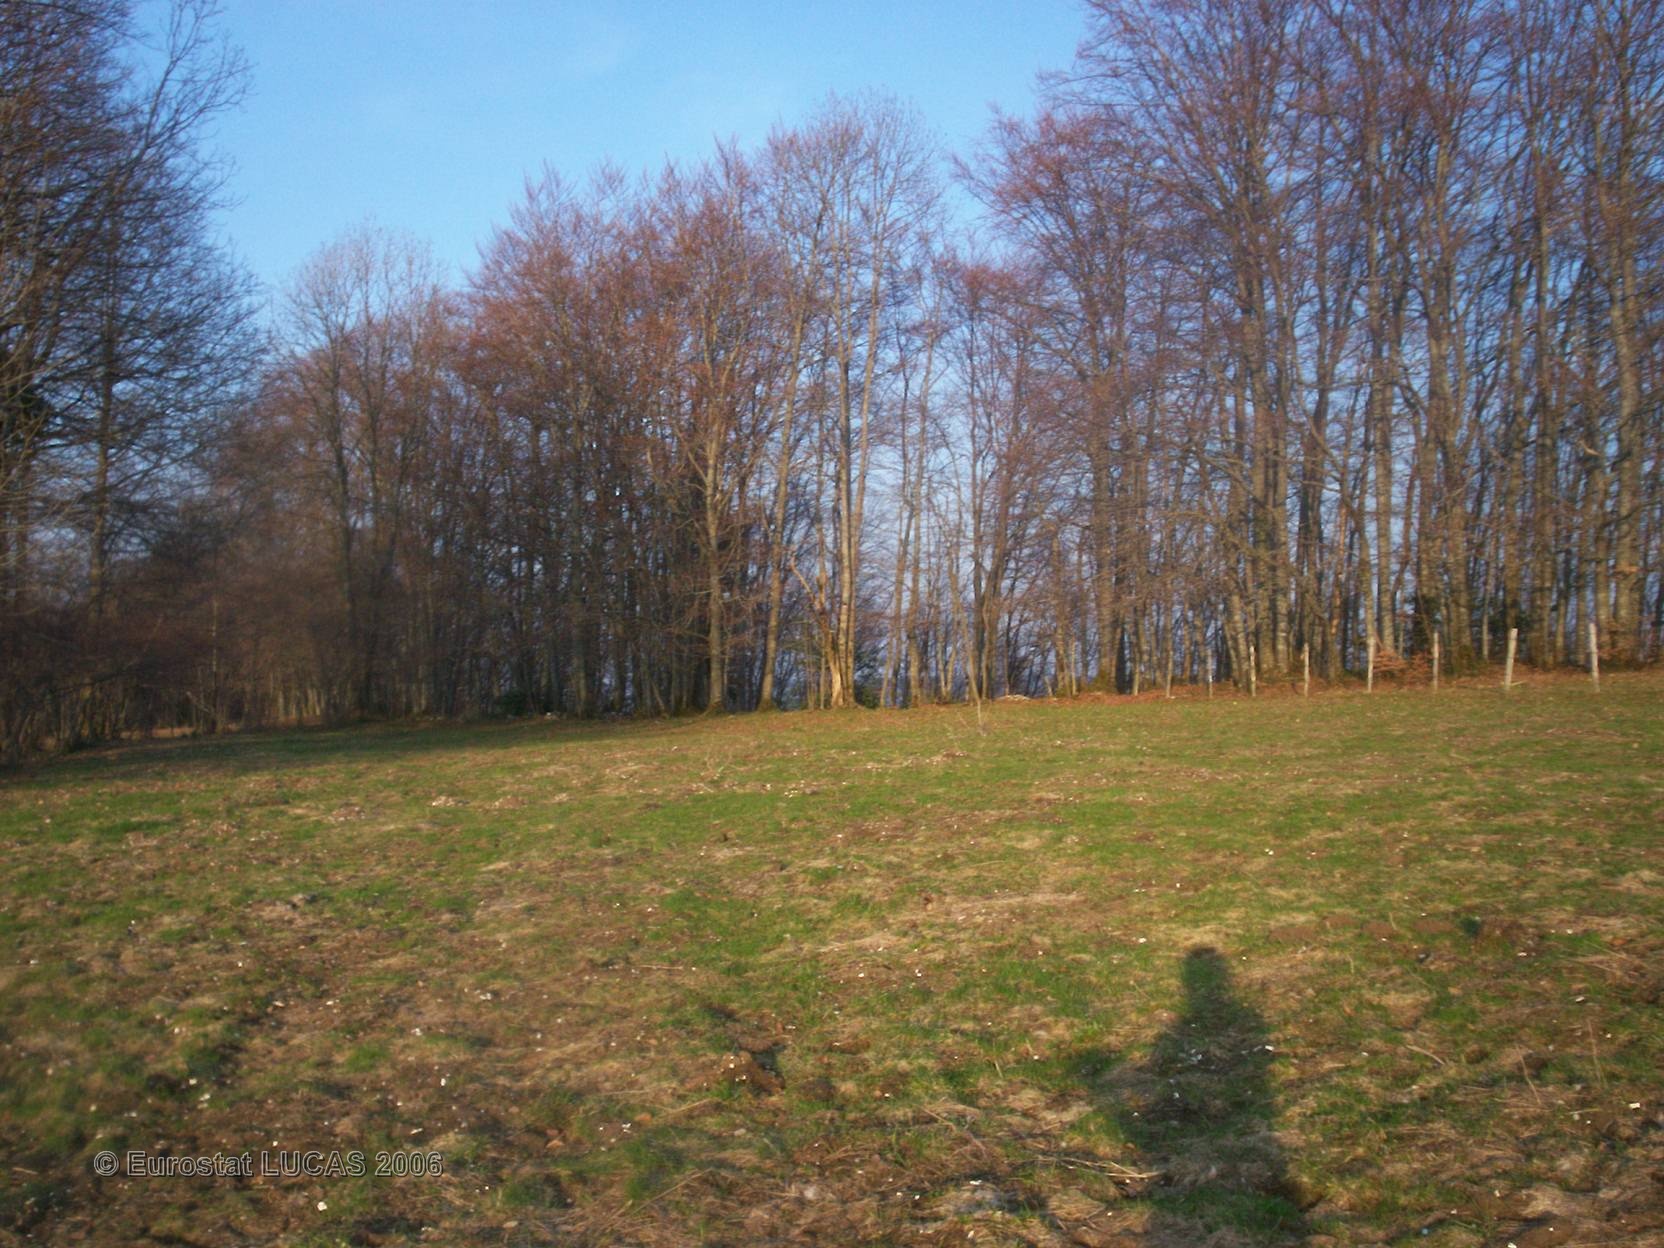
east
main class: Grassland
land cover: Grassland without tree/shrub cover
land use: Agriculture (excluding fallow land and kitchen gardens)
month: April
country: FR
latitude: 47.2800
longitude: 6.9217
